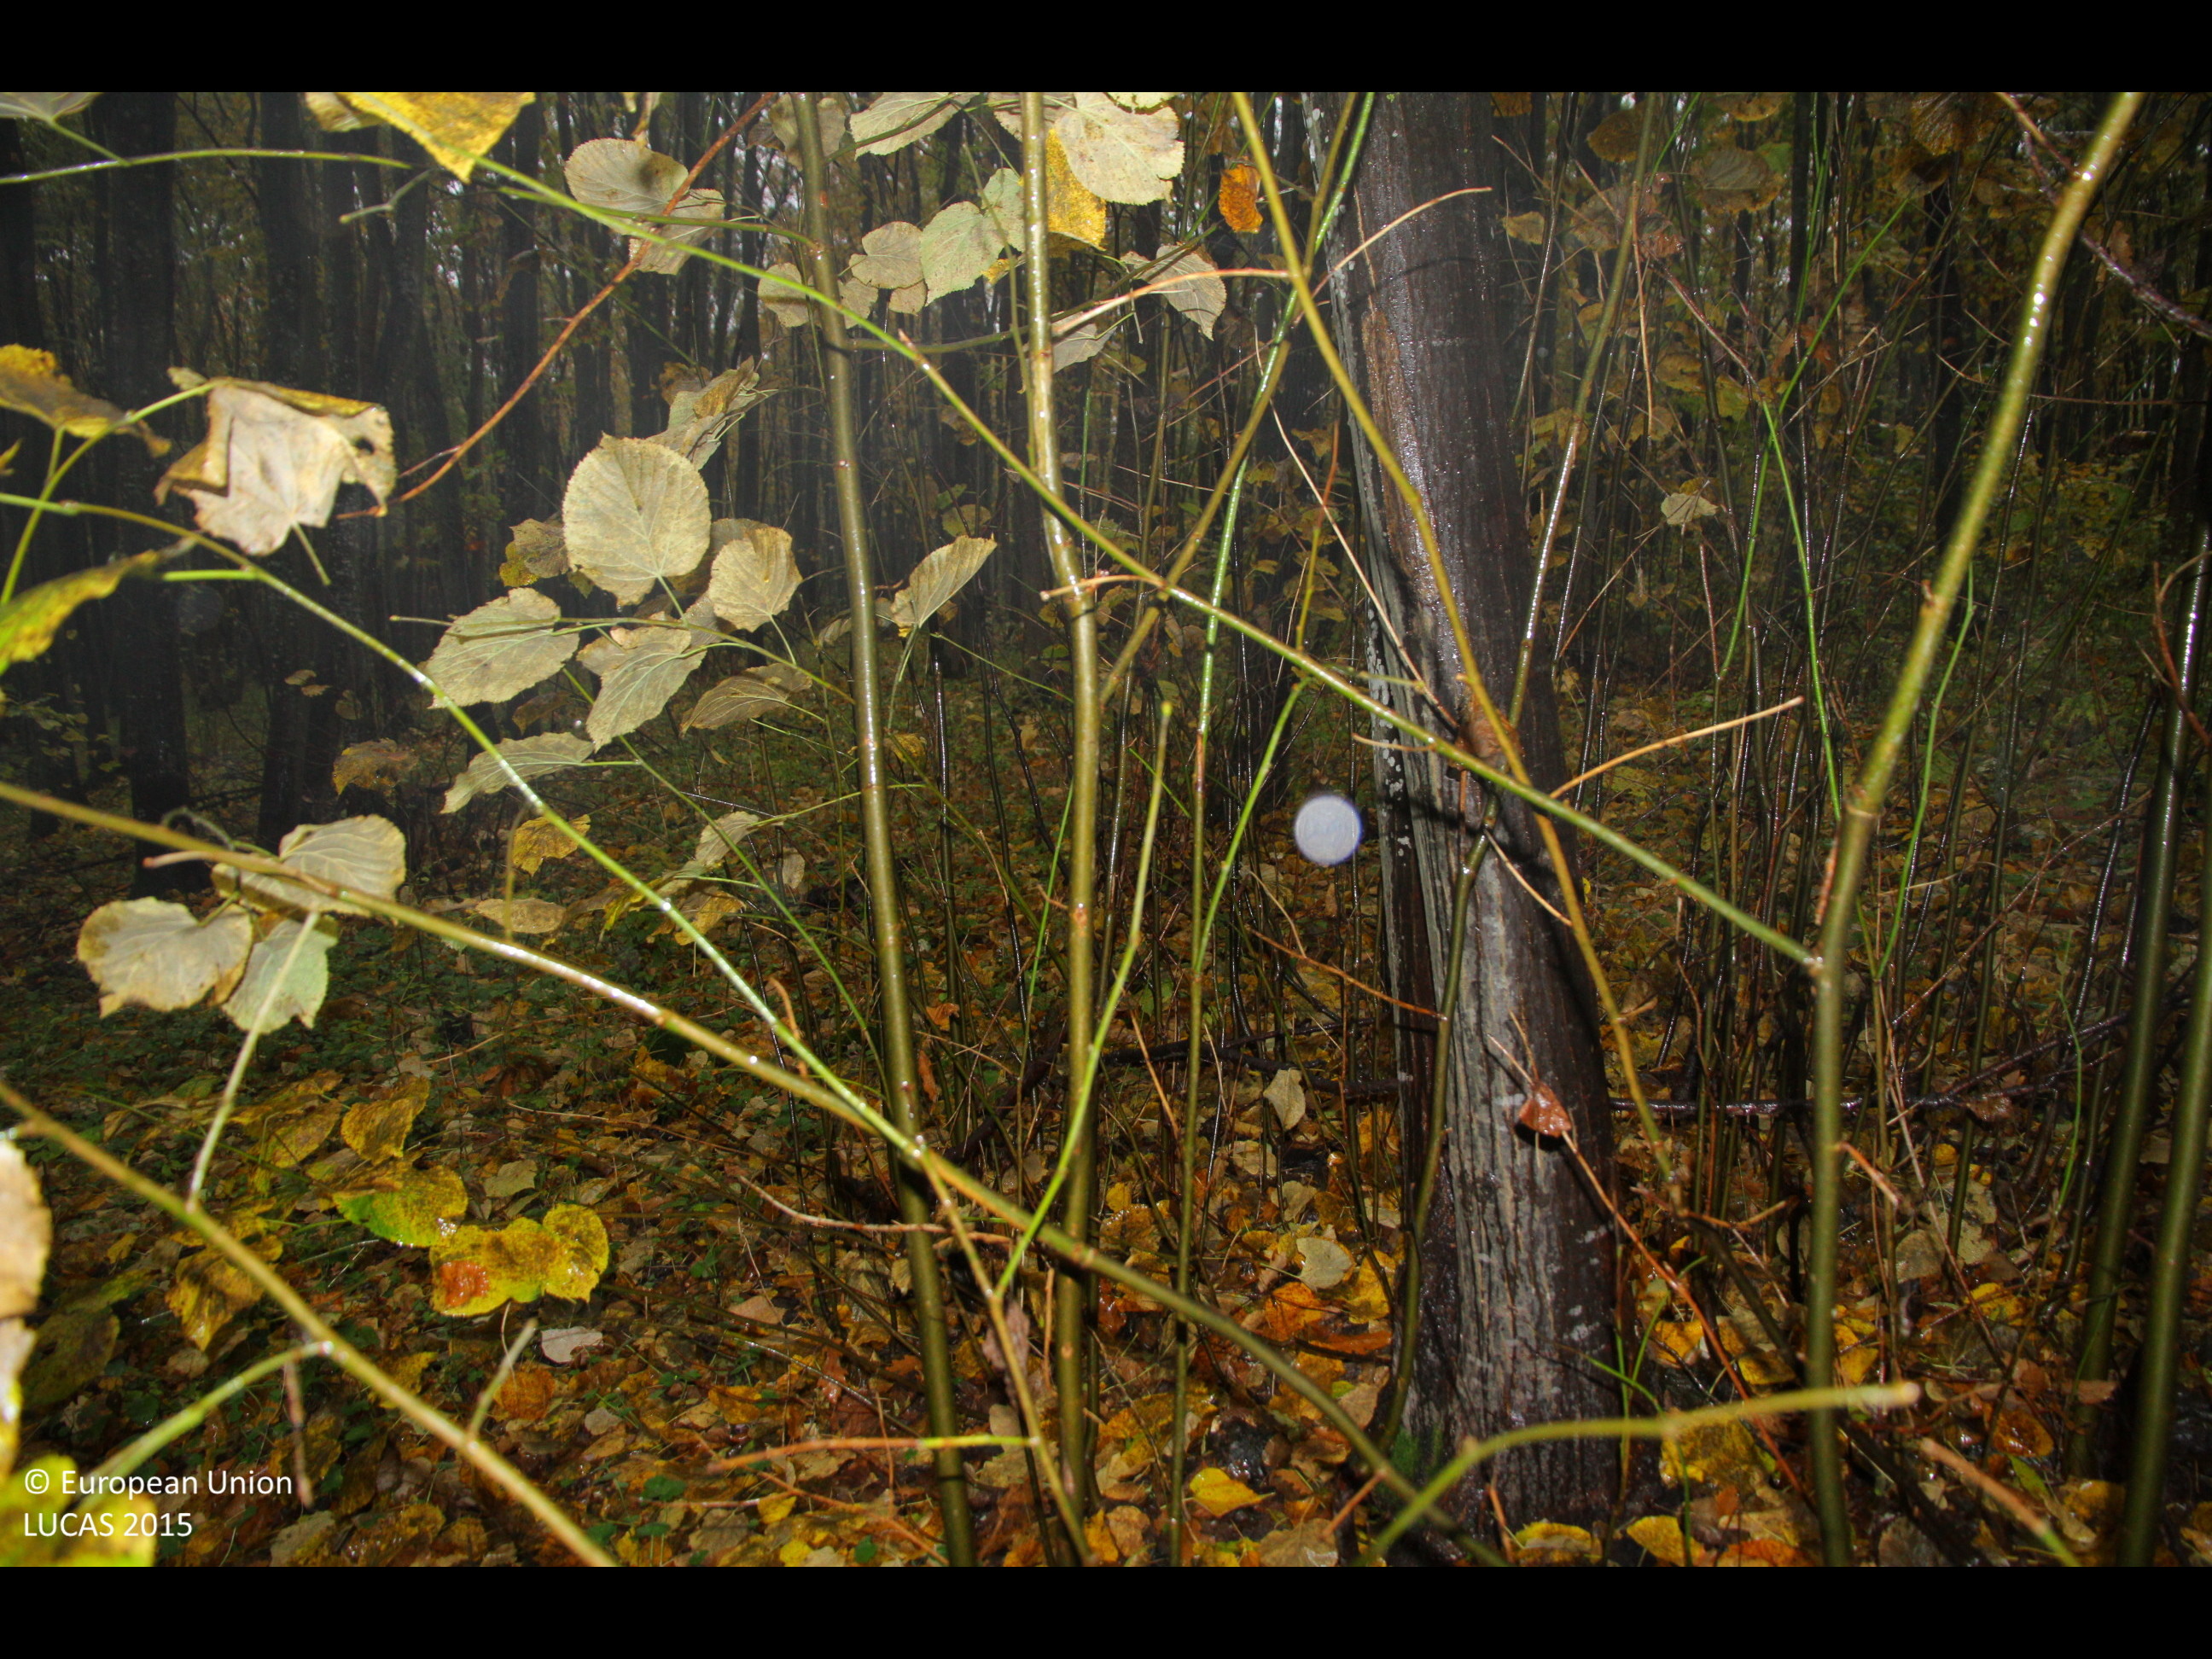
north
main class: Woodland
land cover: Broadleaved woodland
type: beech forest
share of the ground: > 75 %
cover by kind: broadleaved forest trees 100 %
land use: Forestry
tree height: > 5 m
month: October
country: BG
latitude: 43.7595
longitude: 26.4650
